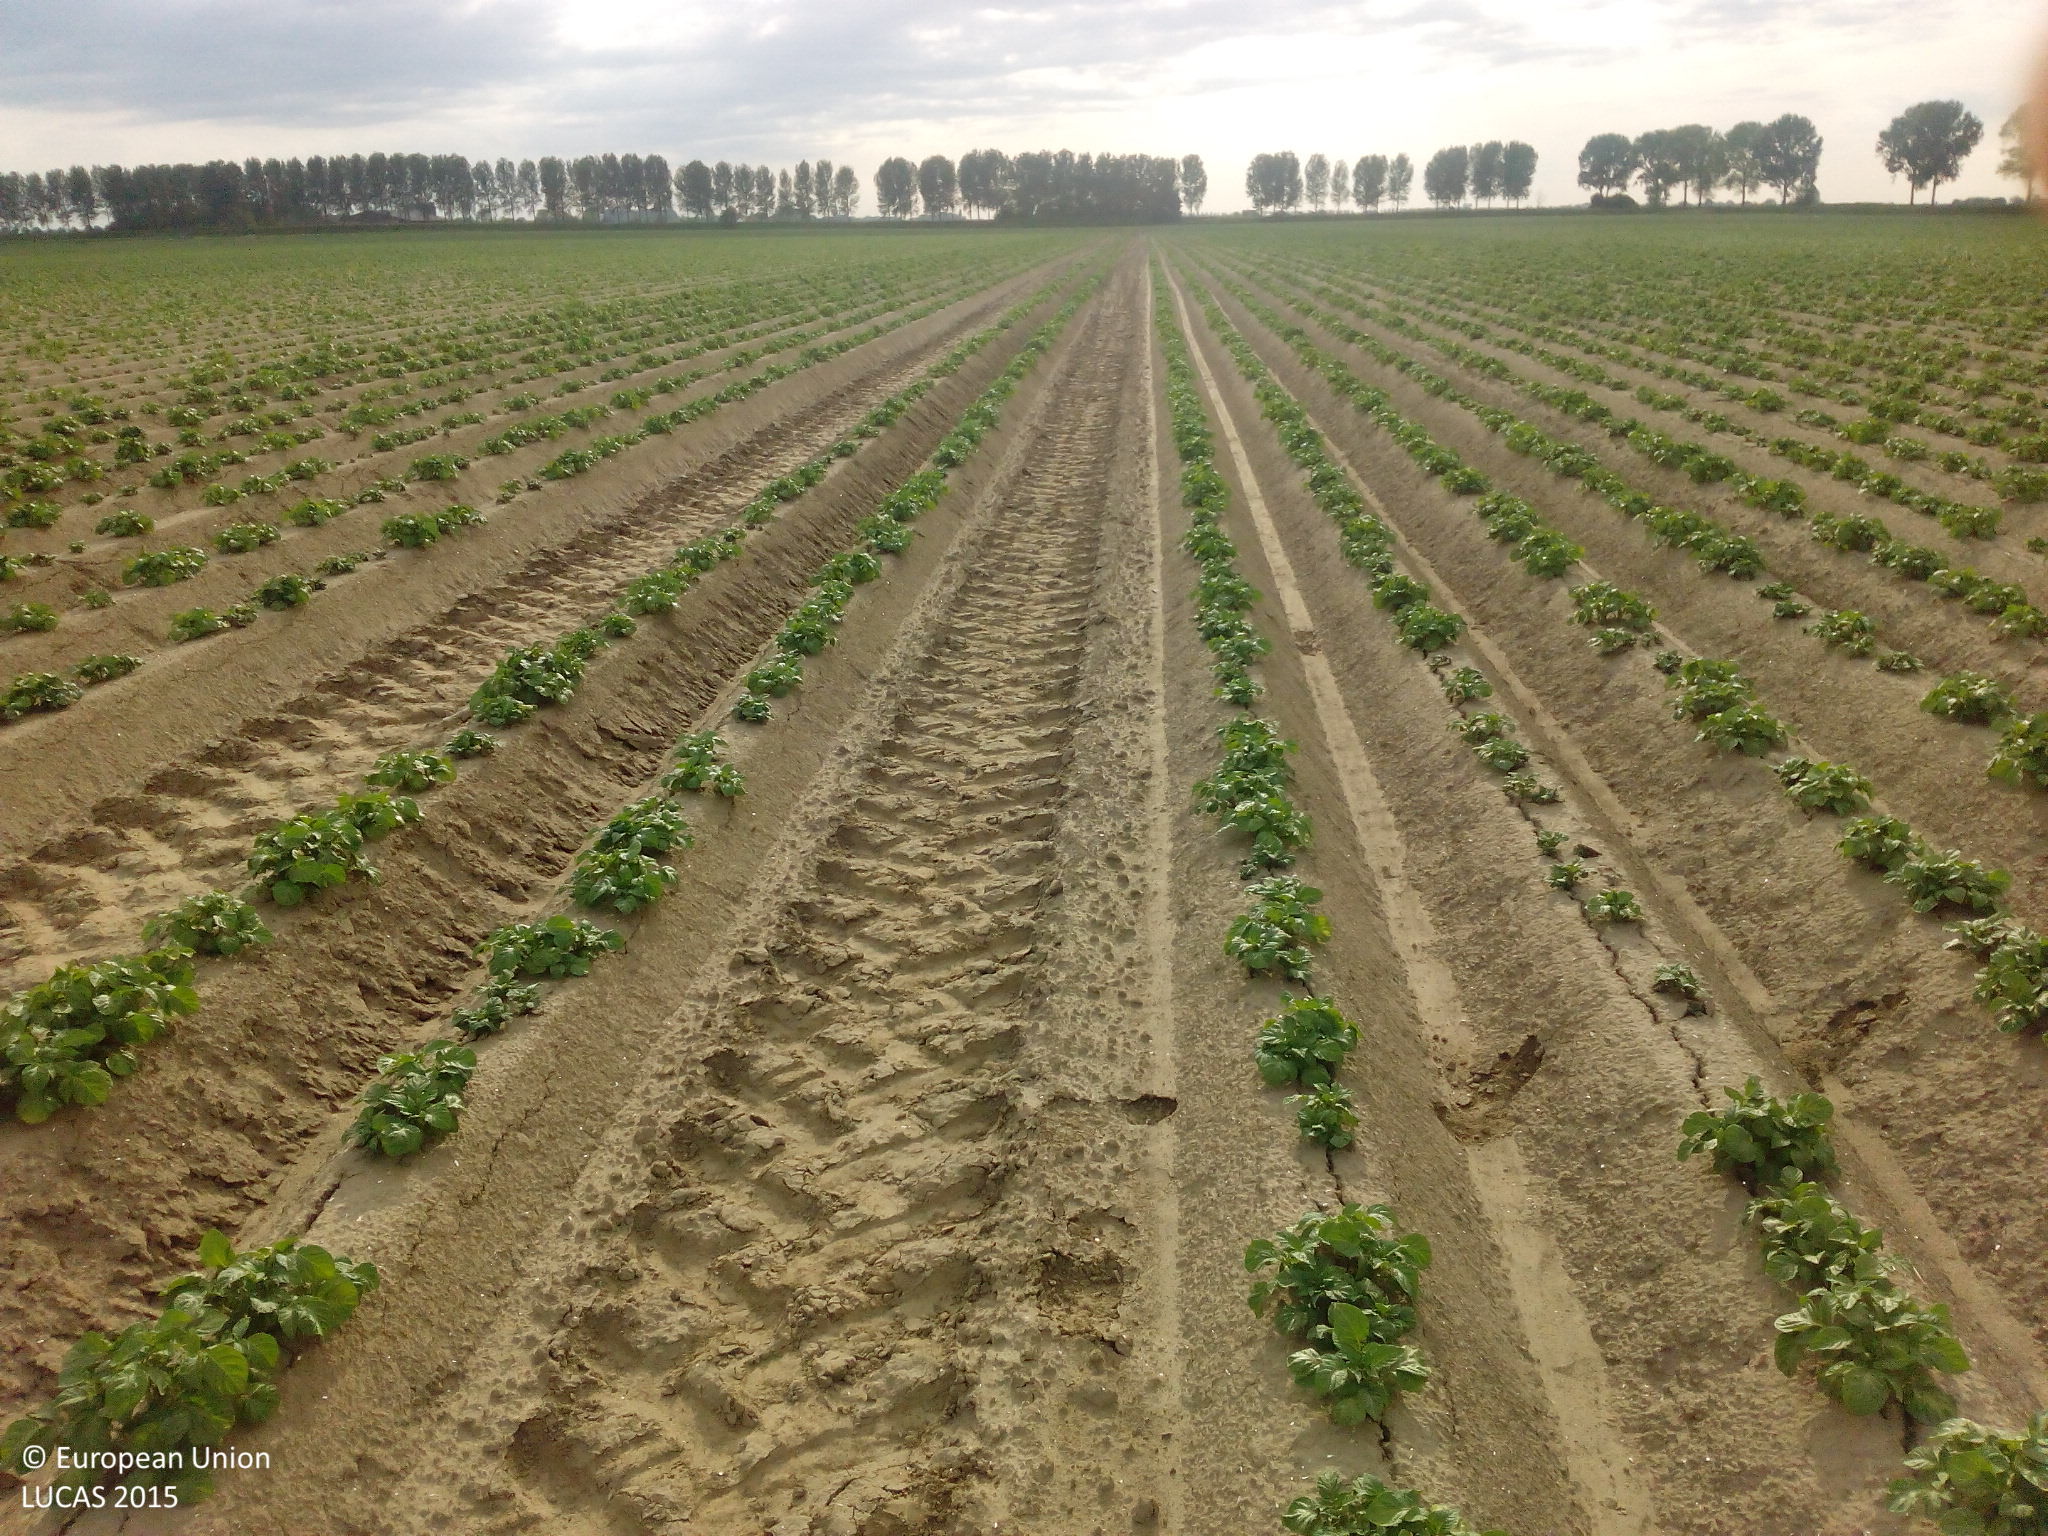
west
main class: Cropland
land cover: Potatoes
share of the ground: < 10 %
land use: Agriculture (excluding fallow land and kitchen gardens)
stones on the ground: < 10 %
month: May
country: NL
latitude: 51.3472
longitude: 4.0936
